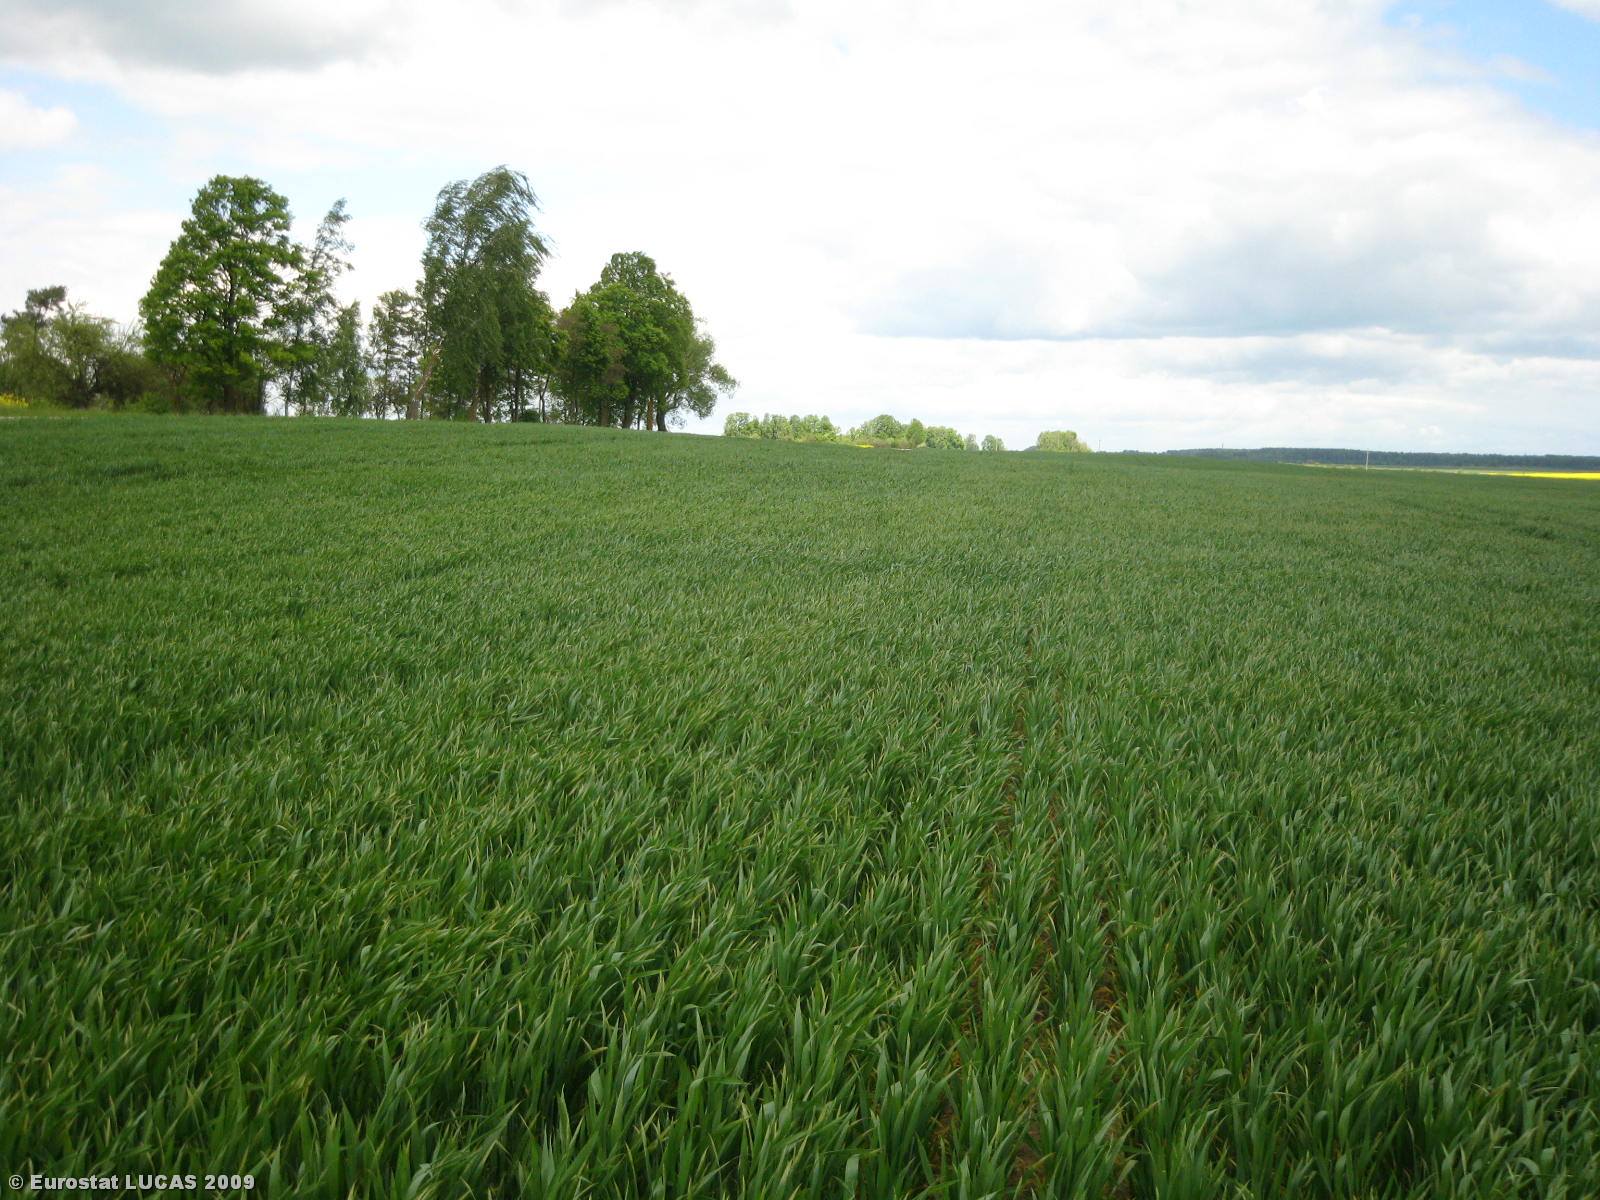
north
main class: Cropland
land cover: Common wheat
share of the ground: > 75 %
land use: Agriculture (excluding fallow land and kitchen gardens)
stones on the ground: < 10 %
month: May
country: LT
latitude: 55.9485
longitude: 24.1341
